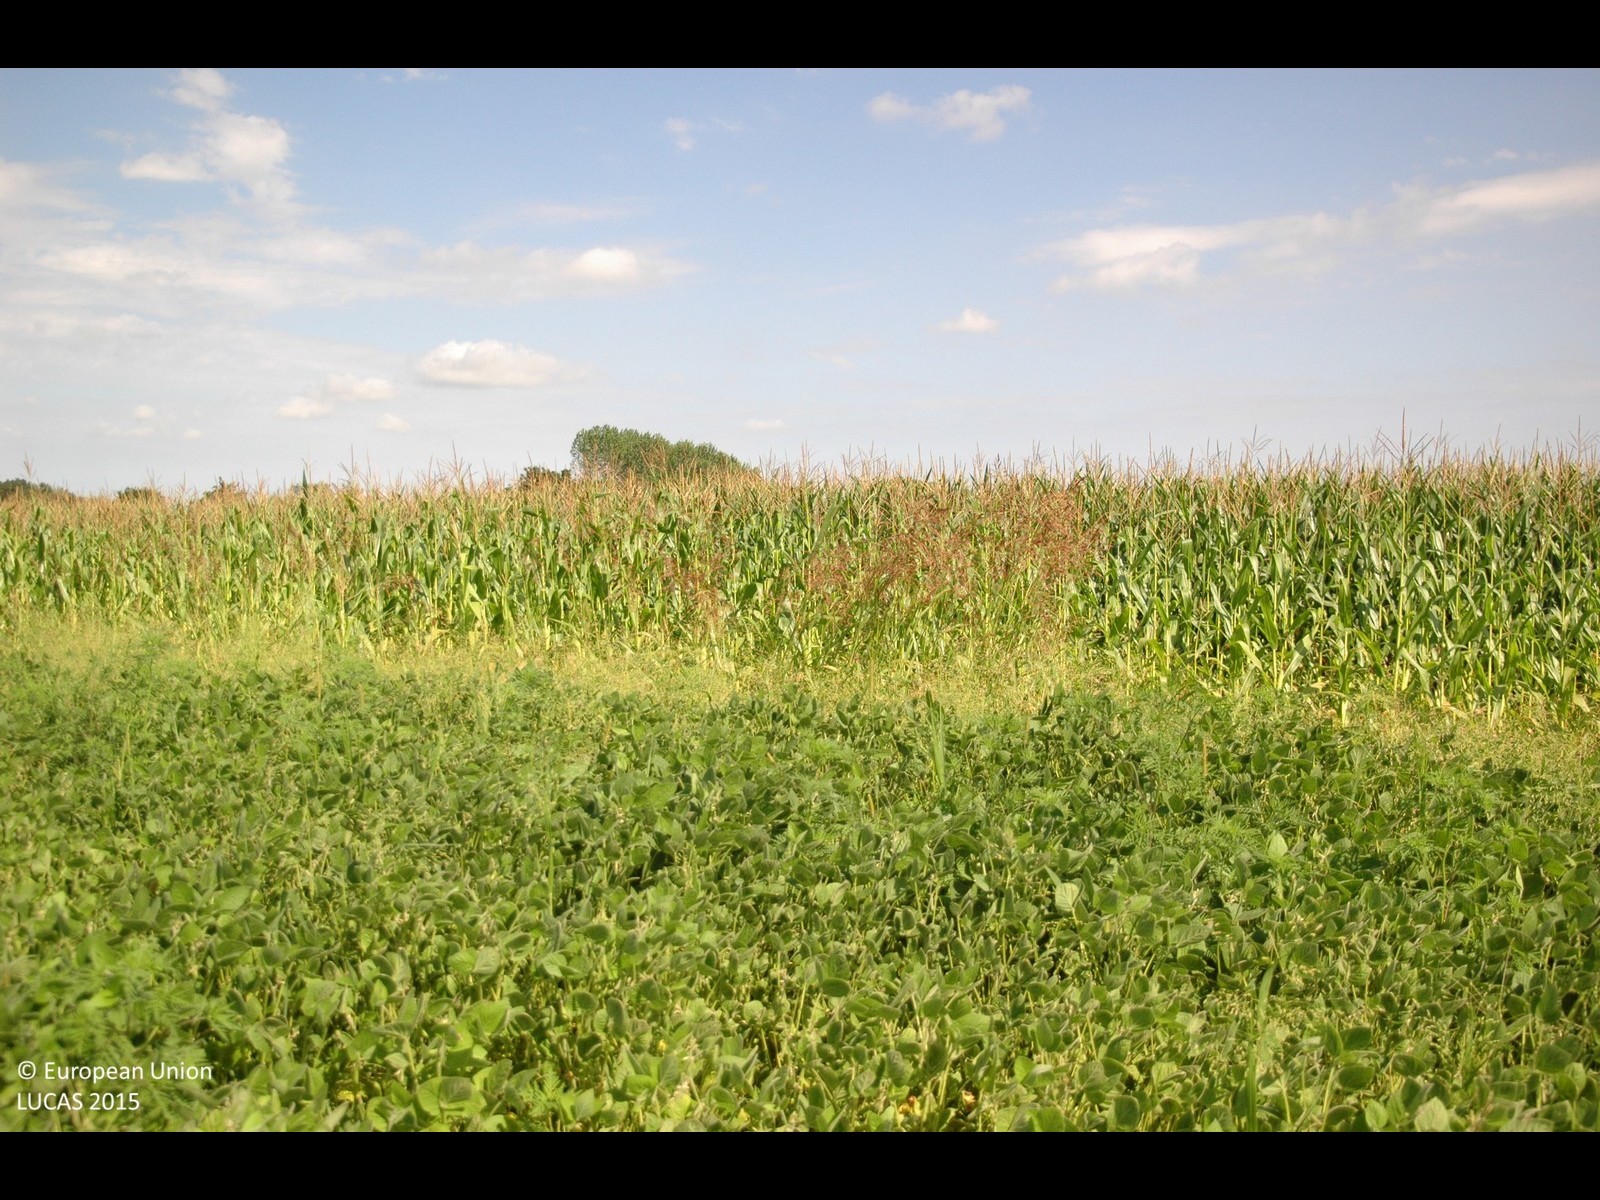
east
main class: Cropland
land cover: Soya
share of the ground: > 75 %
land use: Agriculture (excluding fallow land and kitchen gardens)
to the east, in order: Soya; Maize; Soya; Tracks; Shrubland with sparse tree cover; Rivers and streams; Shrubland with sparse tree cover; Soya
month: July
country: HR
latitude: 46.2132
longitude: 16.7025
